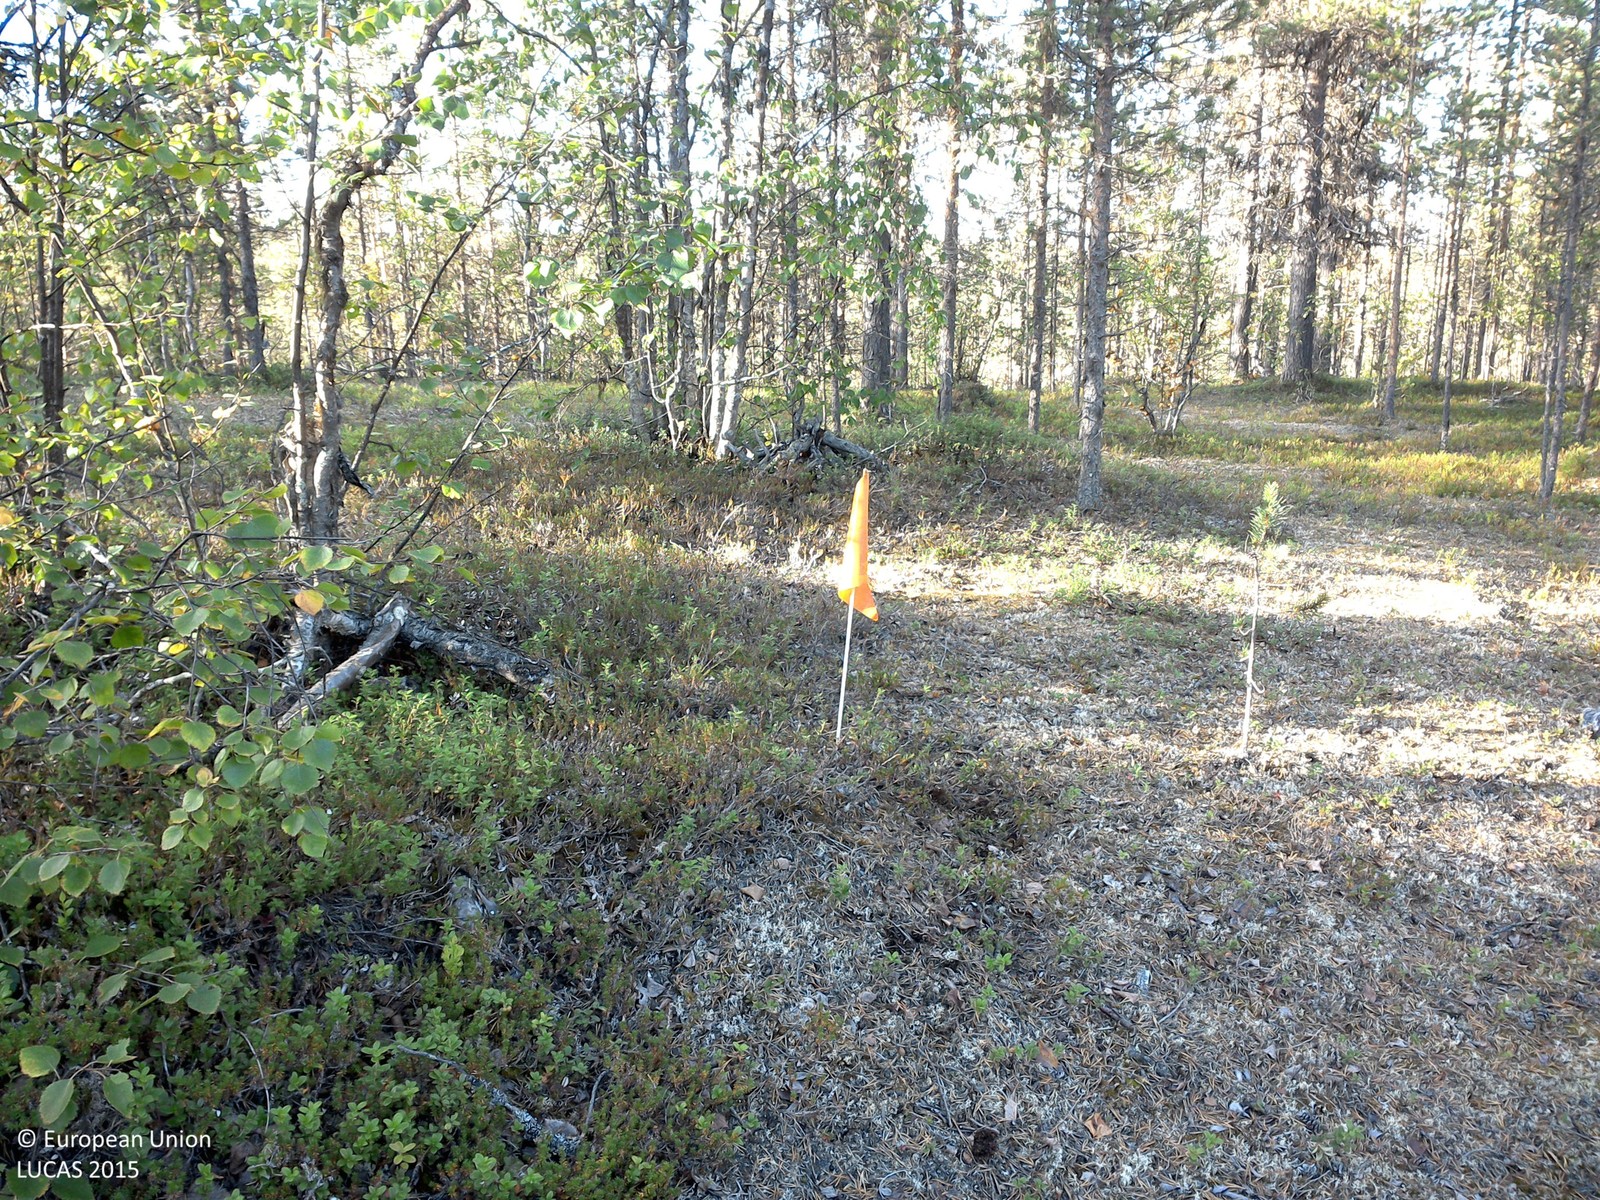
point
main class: Woodland
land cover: Pine dominated mixed woodland
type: boreal forest
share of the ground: 25 - 50 %
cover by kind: shrubs 35 %, lichens and mosses 30 %, coniferous forest trees 25 %, broadleaved forest trees 10 %
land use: Forestry
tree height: > 5 m
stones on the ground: < 10 %
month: August
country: SE
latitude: 68.1245
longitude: 23.0615
